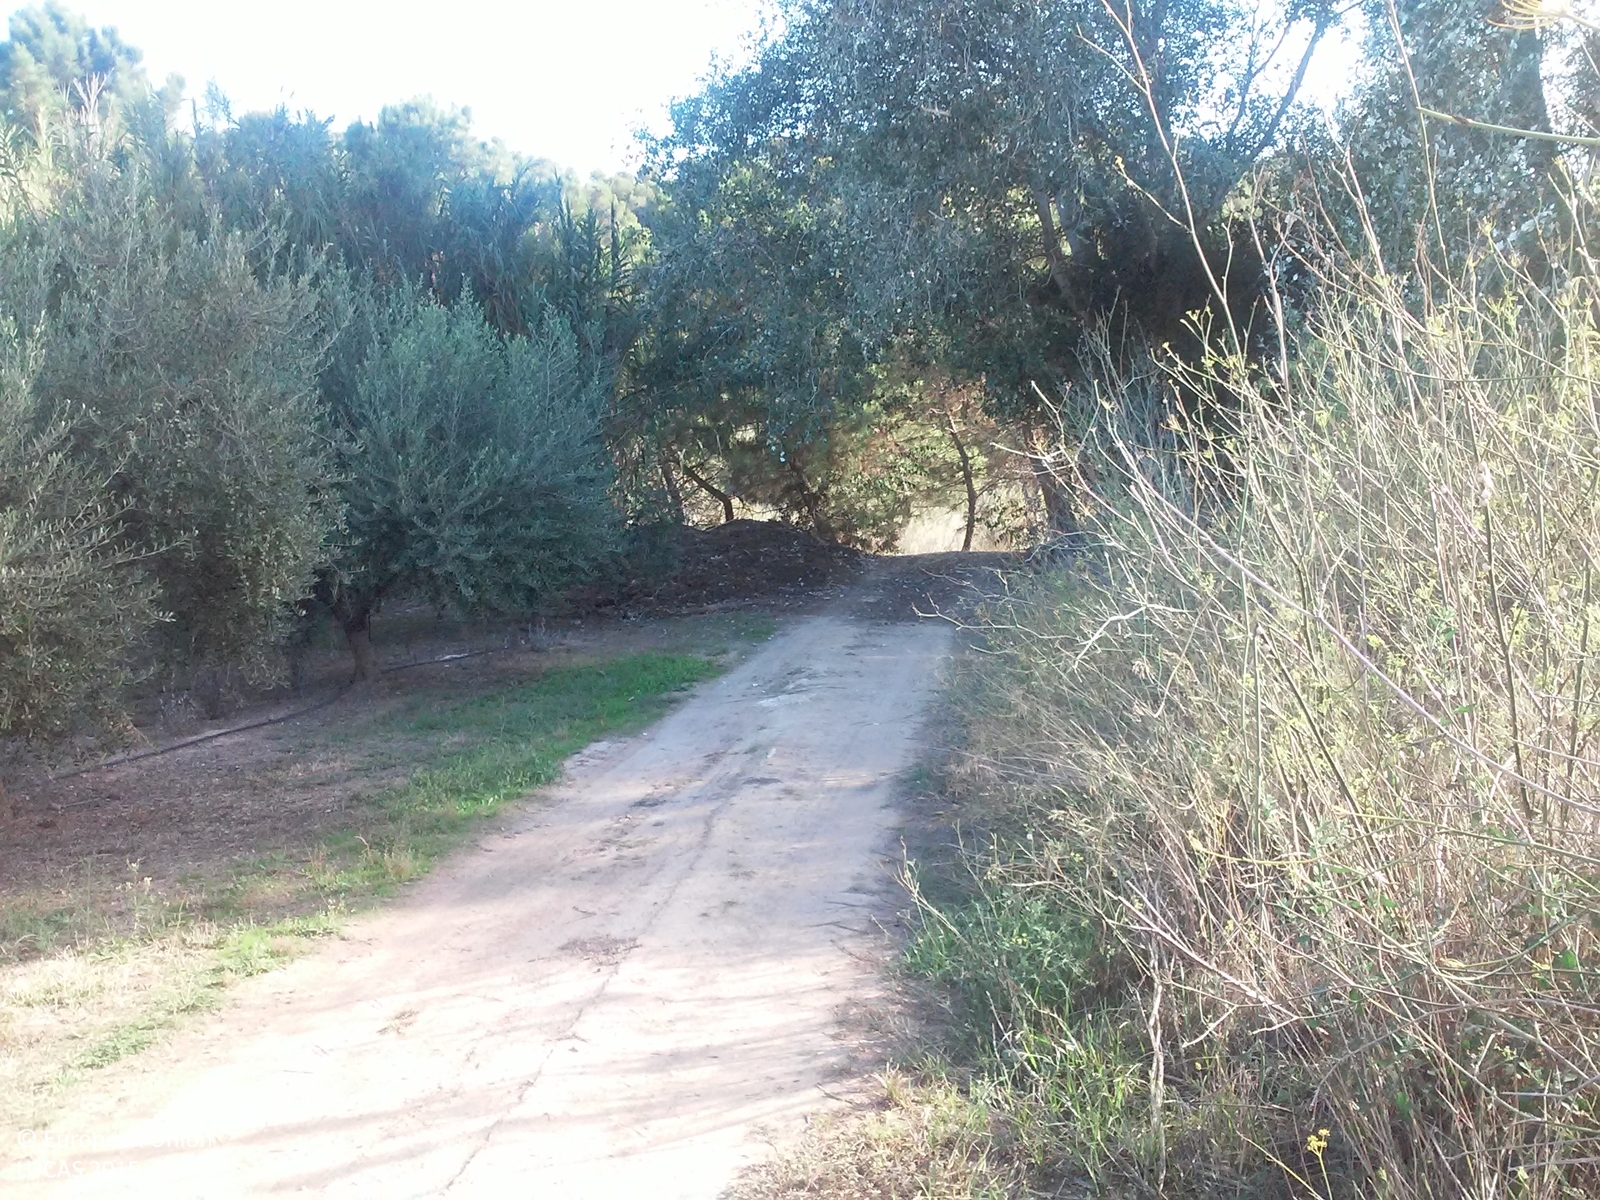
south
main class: Shrubland
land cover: Shrubland with sparse tree cover
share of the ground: 50 - 75 %
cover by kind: shrubs 55 %, herbaceous plants 40 %, broadleaved forest trees 5 %
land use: Abandoned areas
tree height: < 5 m
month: September
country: ES
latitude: 41.1314
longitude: 0.6645
